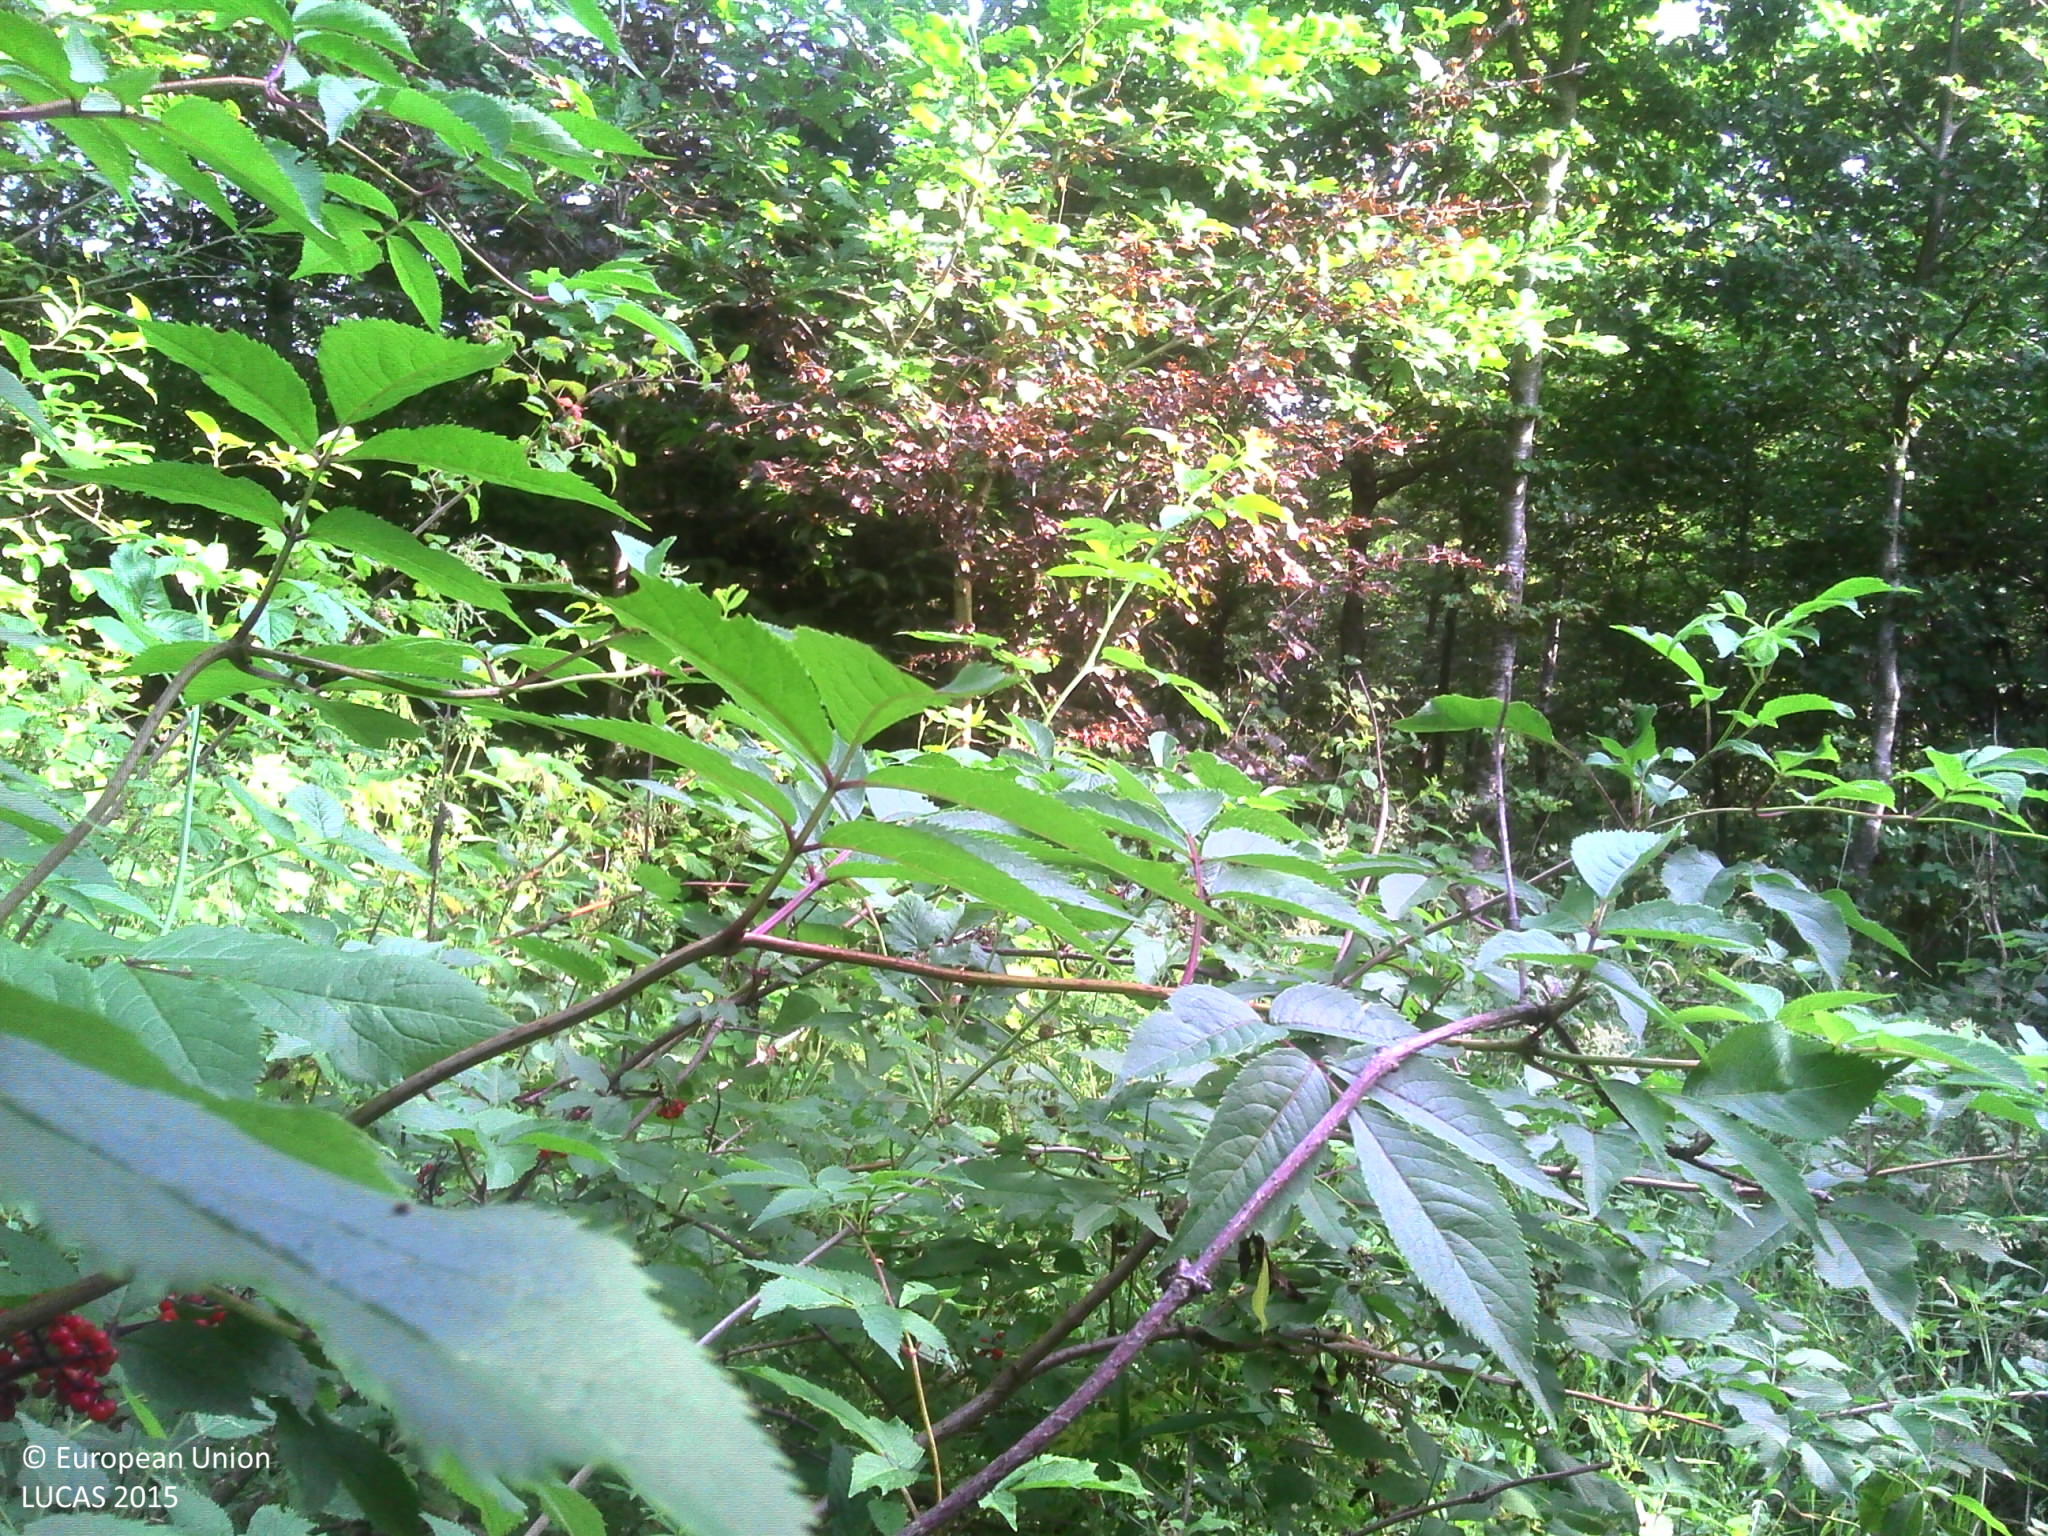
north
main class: Woodland
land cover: Broadleaved woodland
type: acidophilous oak and oak-birch forest
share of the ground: > 75 %
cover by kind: broadleaved forest trees 80 %, herbaceous plants 15 %, shrubs 5 %
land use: Forestry
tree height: > 5 m
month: July
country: BE
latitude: 49.9355
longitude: 5.5540
